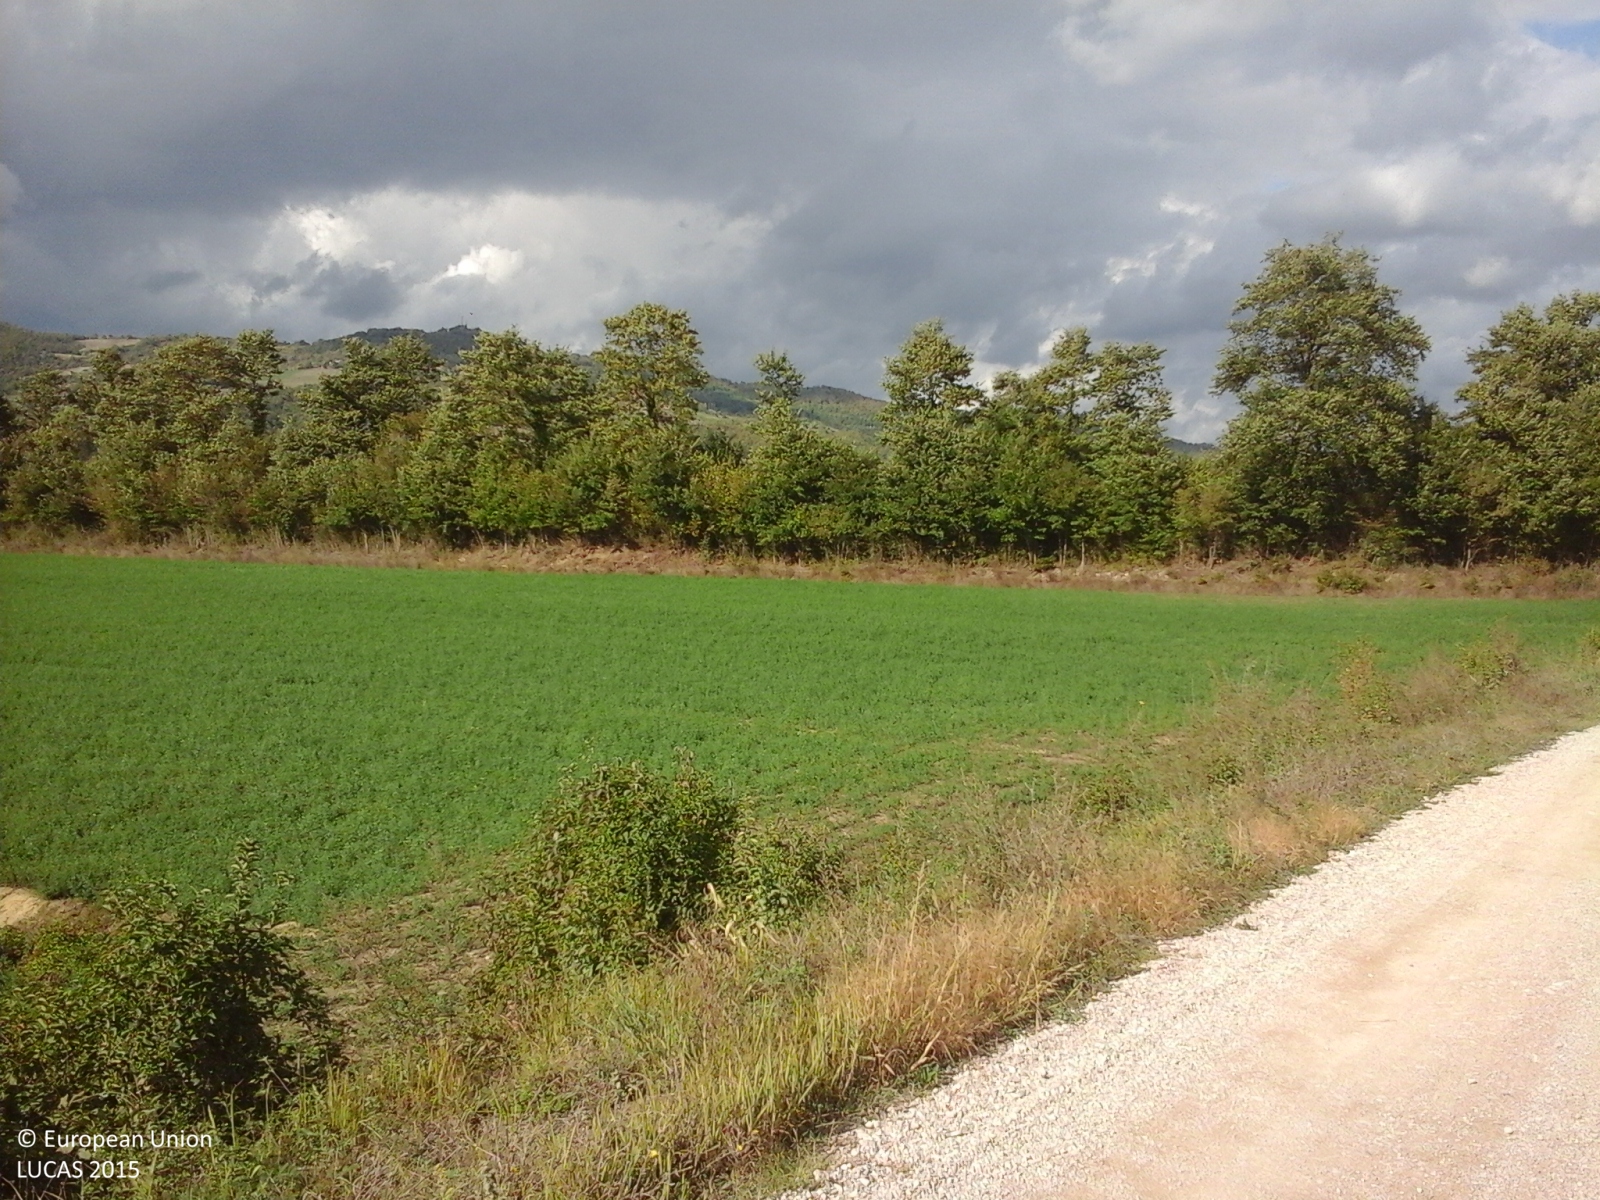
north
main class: Shrubland
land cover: Shrubland without tree cover
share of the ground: 50 - 75 %
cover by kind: shrubs 70 %, herbaceous plants 30 %
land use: Abandoned areas
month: October
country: IT
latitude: 43.2974
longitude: 12.2494
